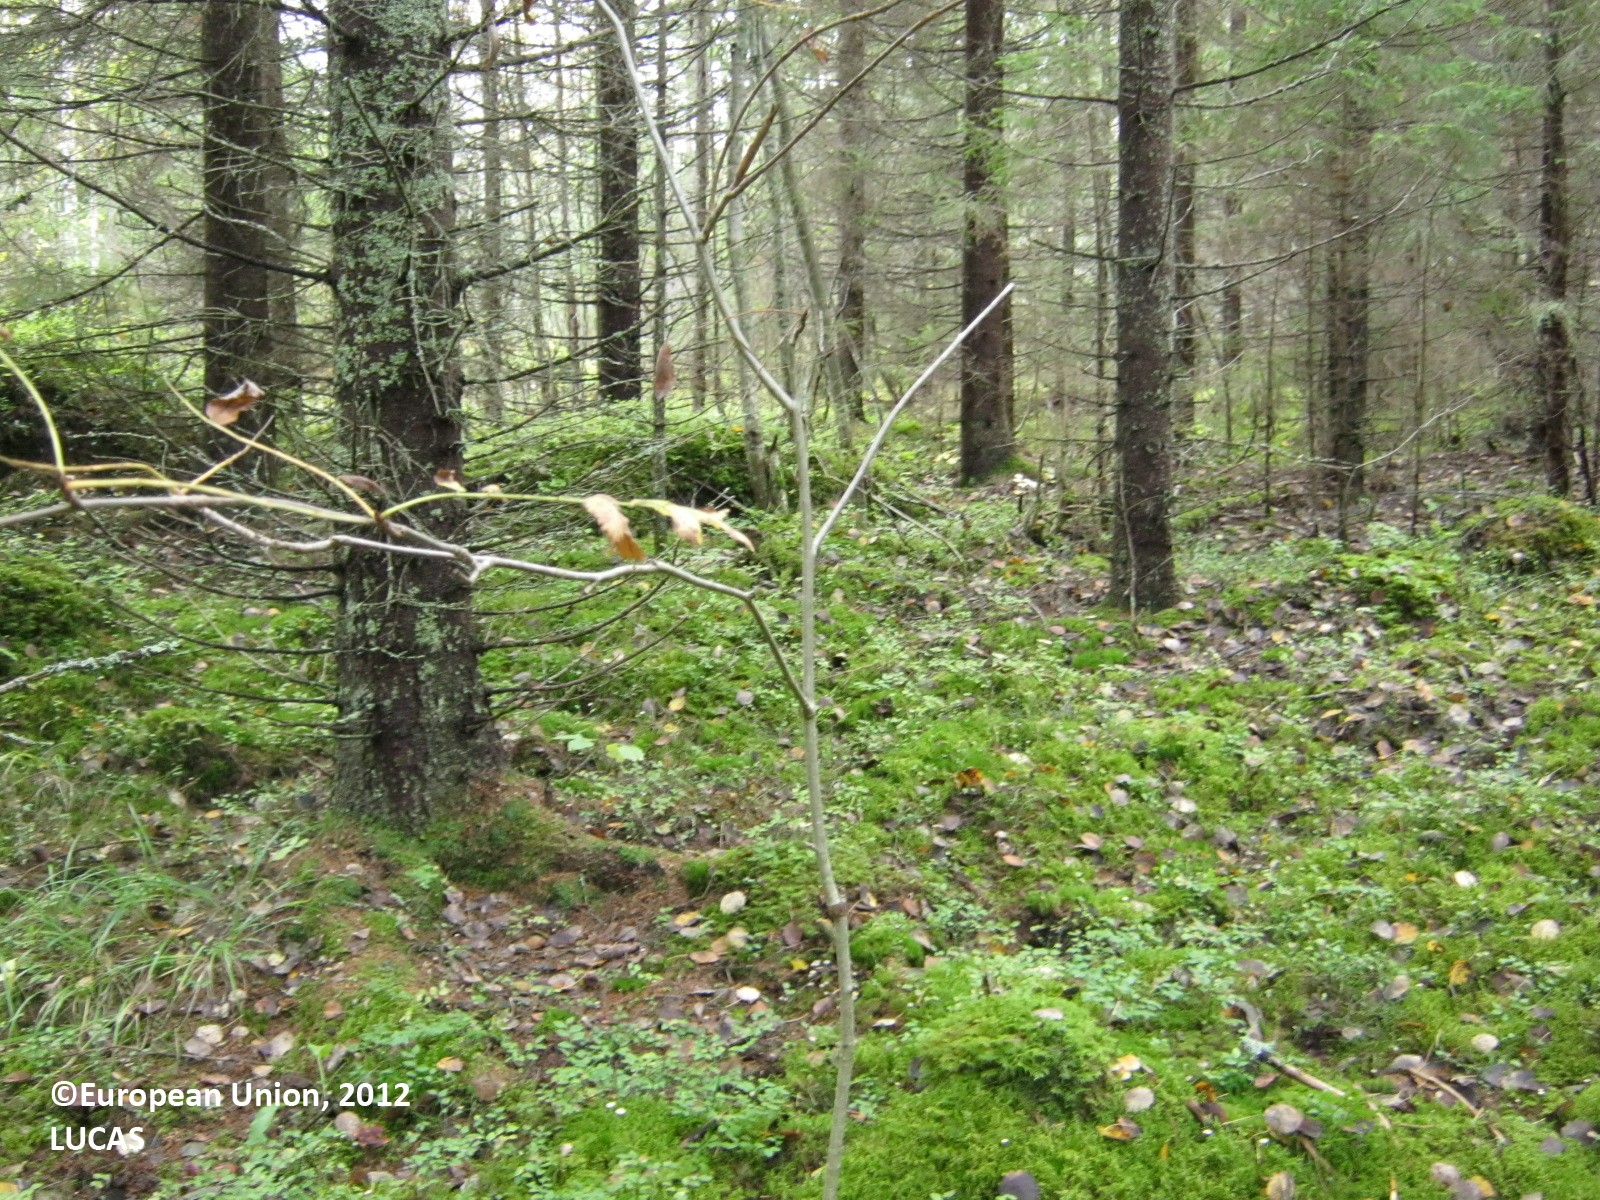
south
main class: Woodland
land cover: Spruce dominated coniferous woodland
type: boreal forest
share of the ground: 50 - 75 %
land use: Forestry
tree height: > 5 m
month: September
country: FI
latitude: 62.5238
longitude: 27.4767
